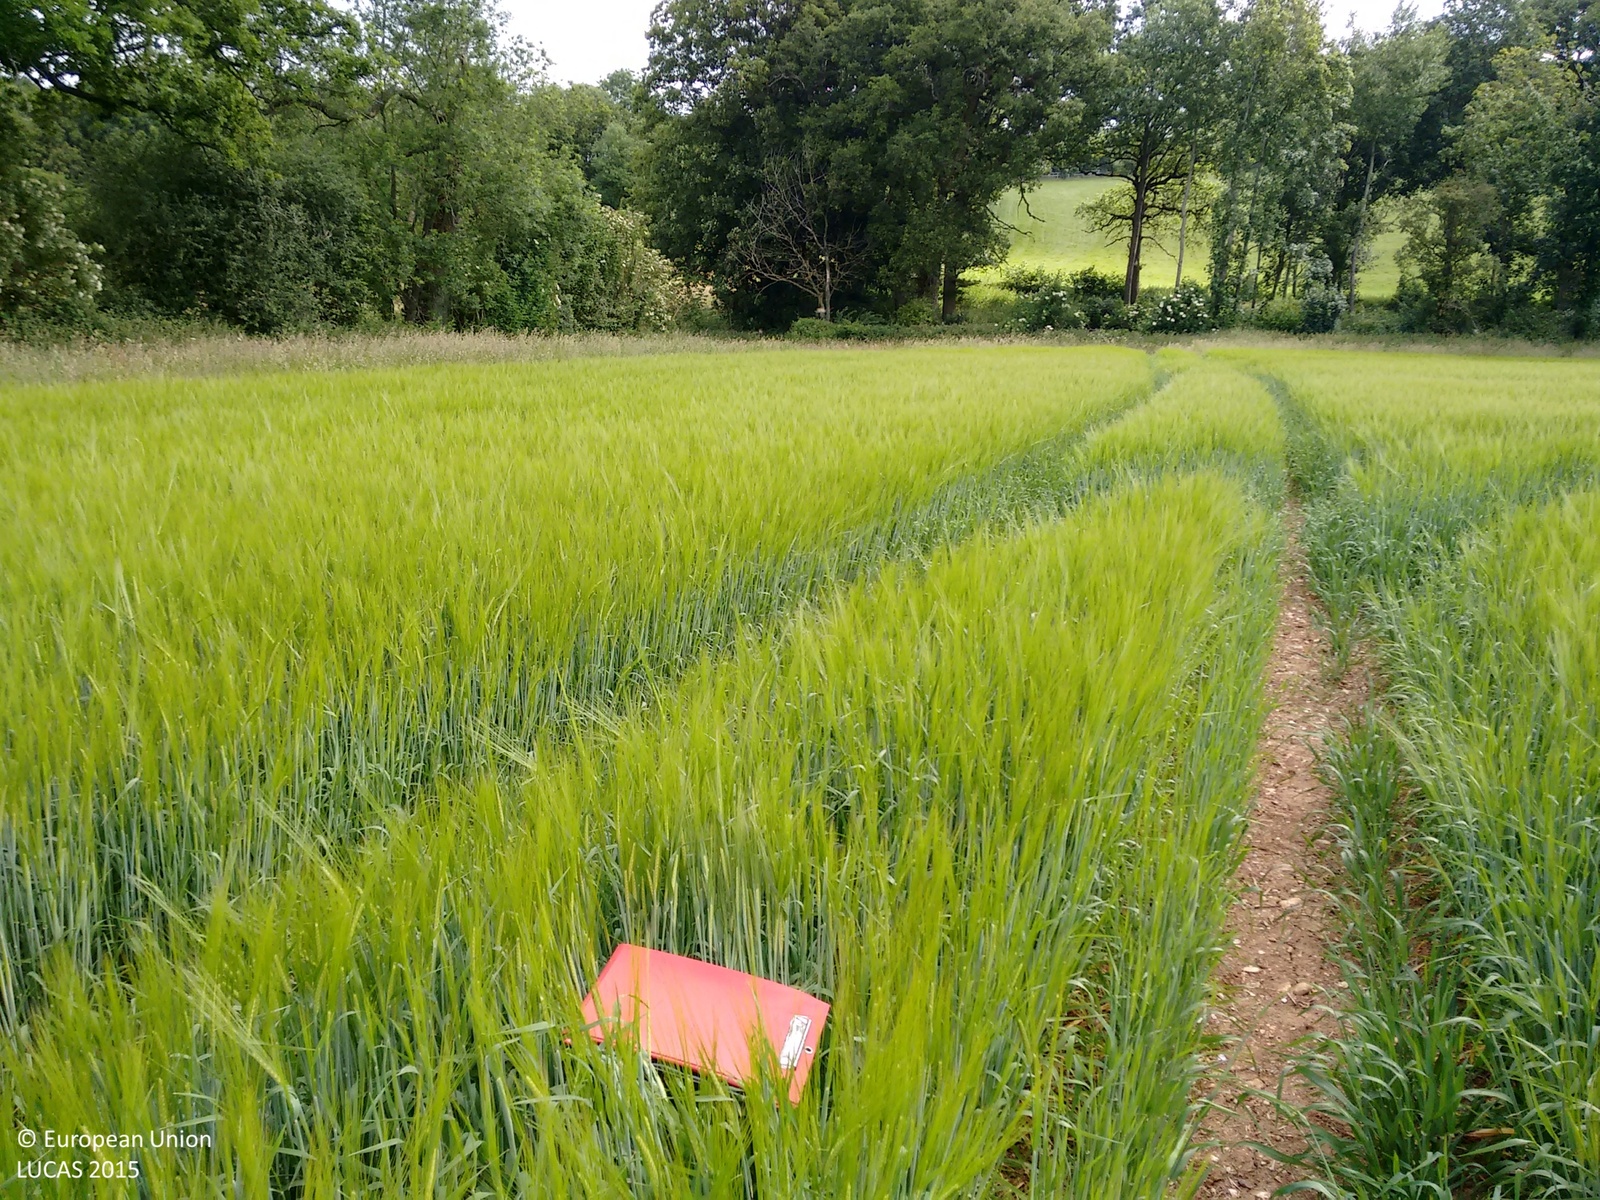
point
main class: Cropland
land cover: Barley
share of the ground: > 75 %
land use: Agriculture (excluding fallow land and kitchen gardens)
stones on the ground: 25 - 50 %
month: June
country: GB
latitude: 51.4539
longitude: -1.4919
